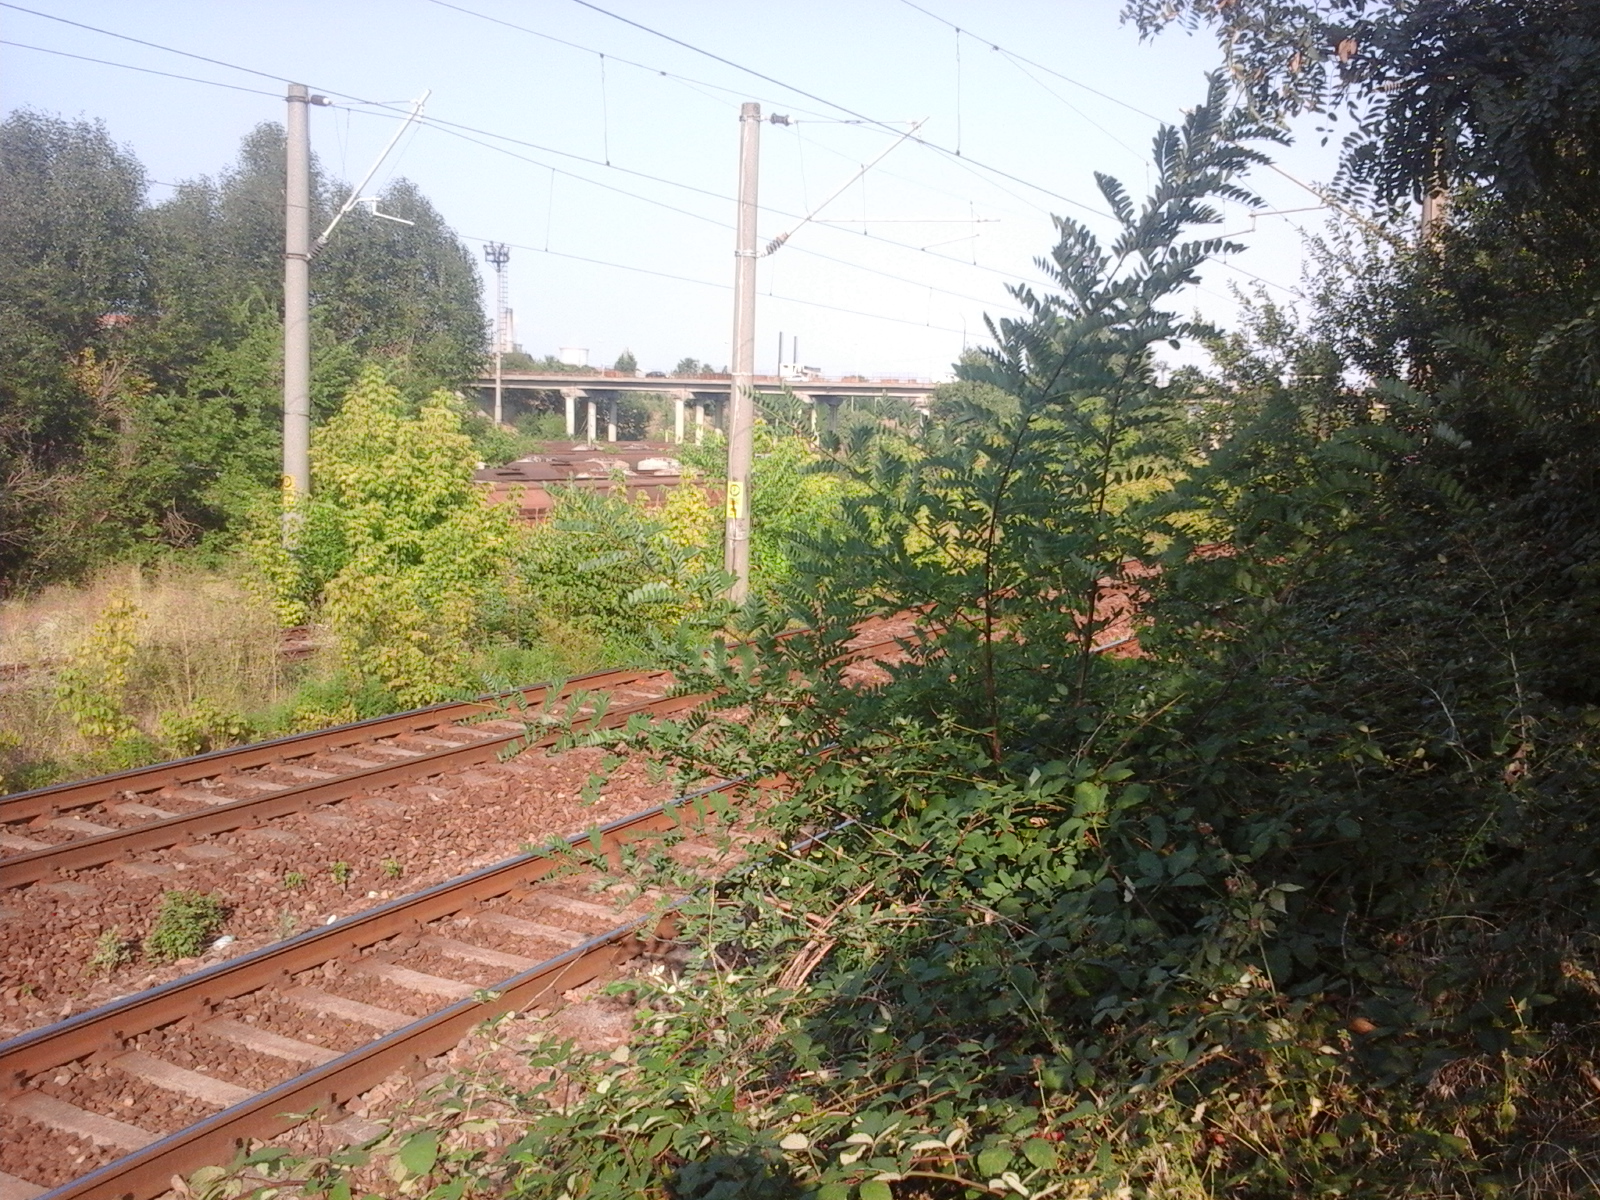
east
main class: Woodland
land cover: Broadleaved woodland
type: exotic forest
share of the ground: > 75 %
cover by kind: broadleaved forest trees 100 %
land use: Semi-natural and natural areas not in use
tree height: > 5 m
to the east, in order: Broadleaved woodland; Artificial constructions in urban areas
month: August
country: RO
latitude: 44.3385
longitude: 23.7907
